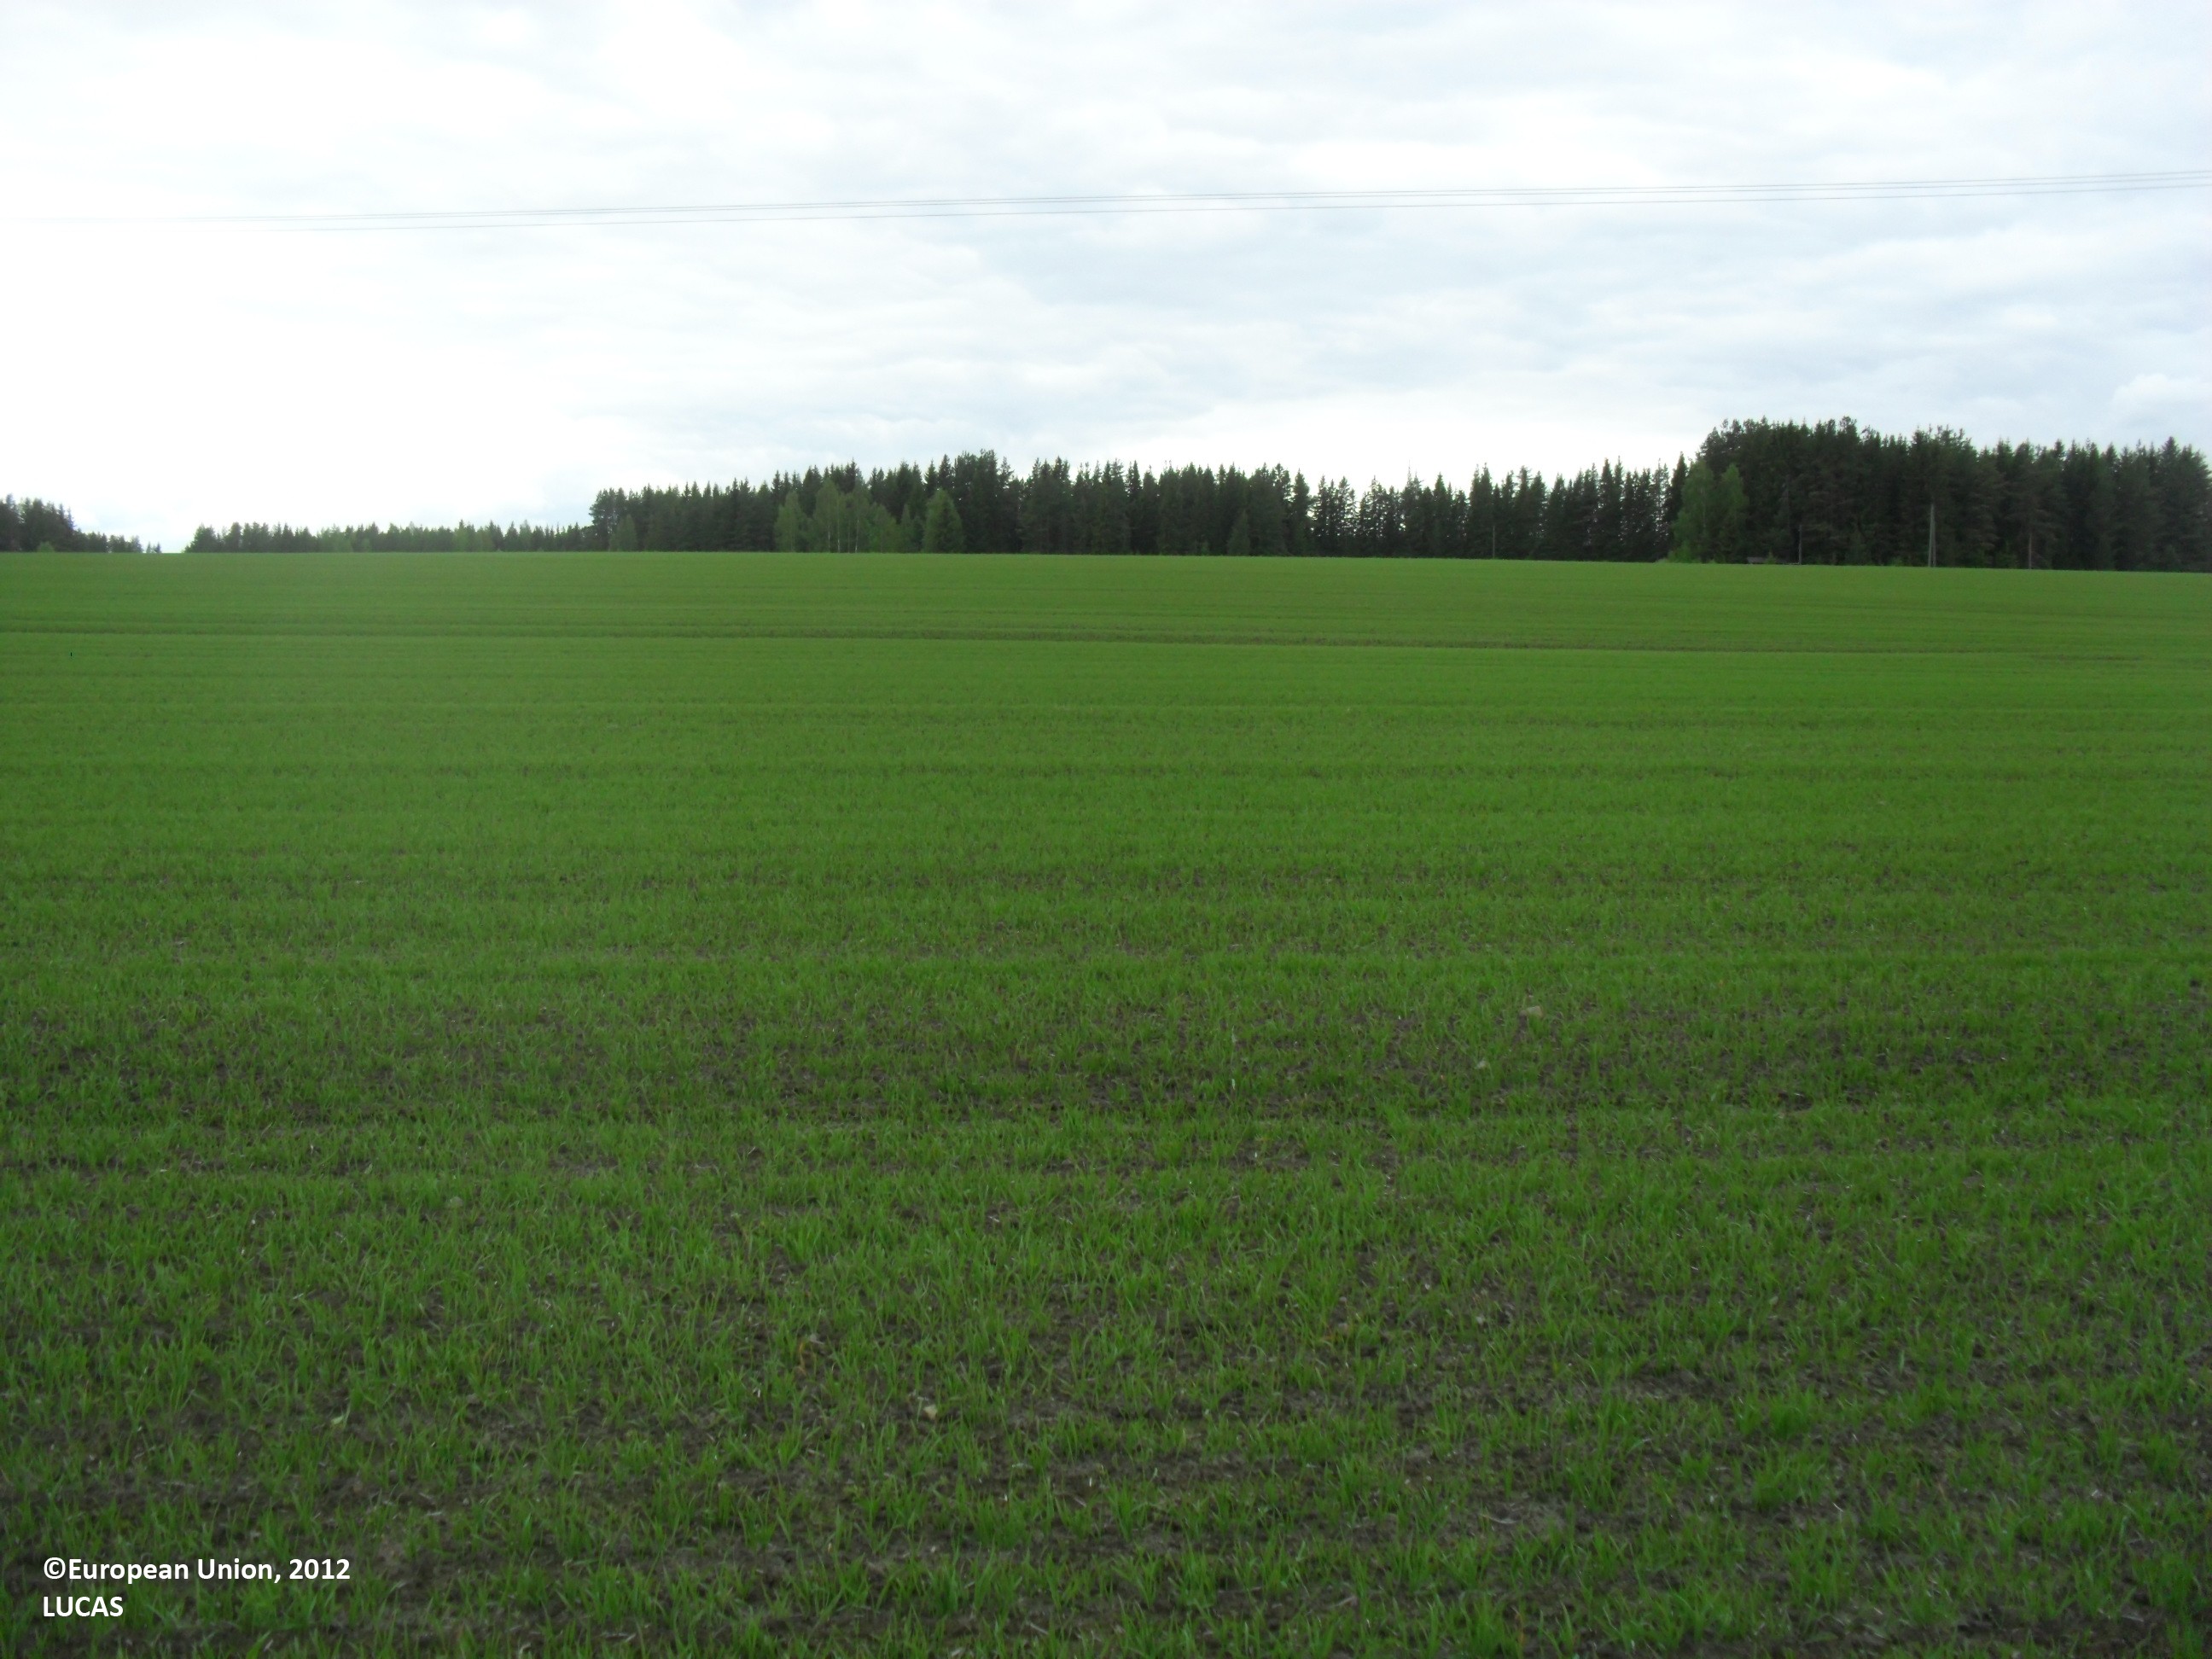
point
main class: Cropland
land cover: Oats
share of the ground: < 10 %
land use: Agriculture (excluding fallow land and kitchen gardens)
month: June
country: FI
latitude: 62.9256
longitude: 22.9980
